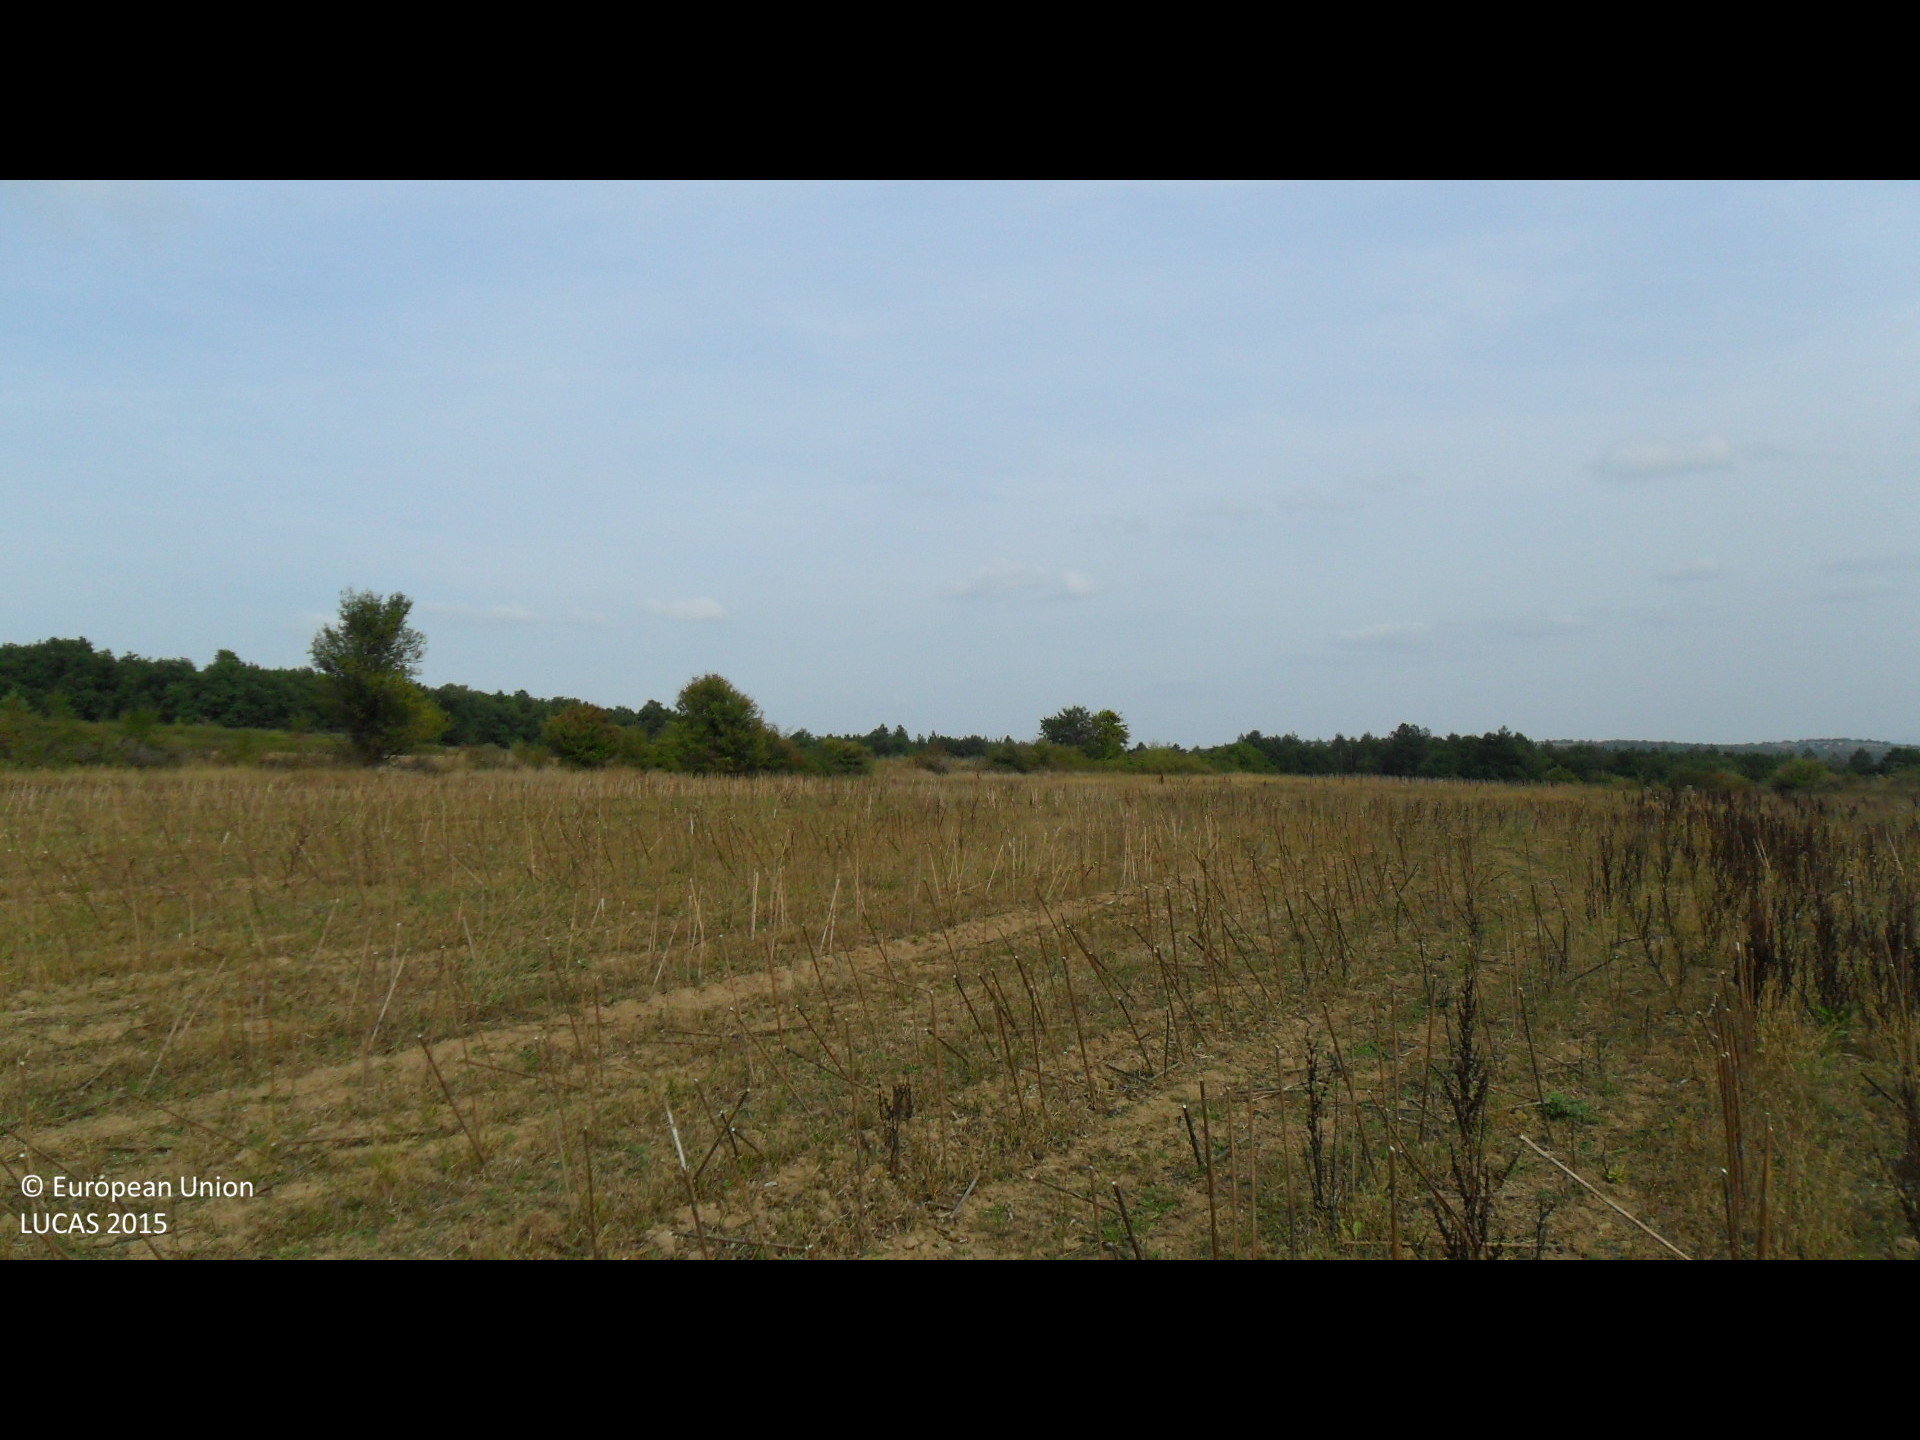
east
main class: Cropland
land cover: Sunflower
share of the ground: 25 - 50 %
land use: Agriculture (excluding fallow land and kitchen gardens)
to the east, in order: Sunflower
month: September
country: BG
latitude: 43.0472
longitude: 26.4372
